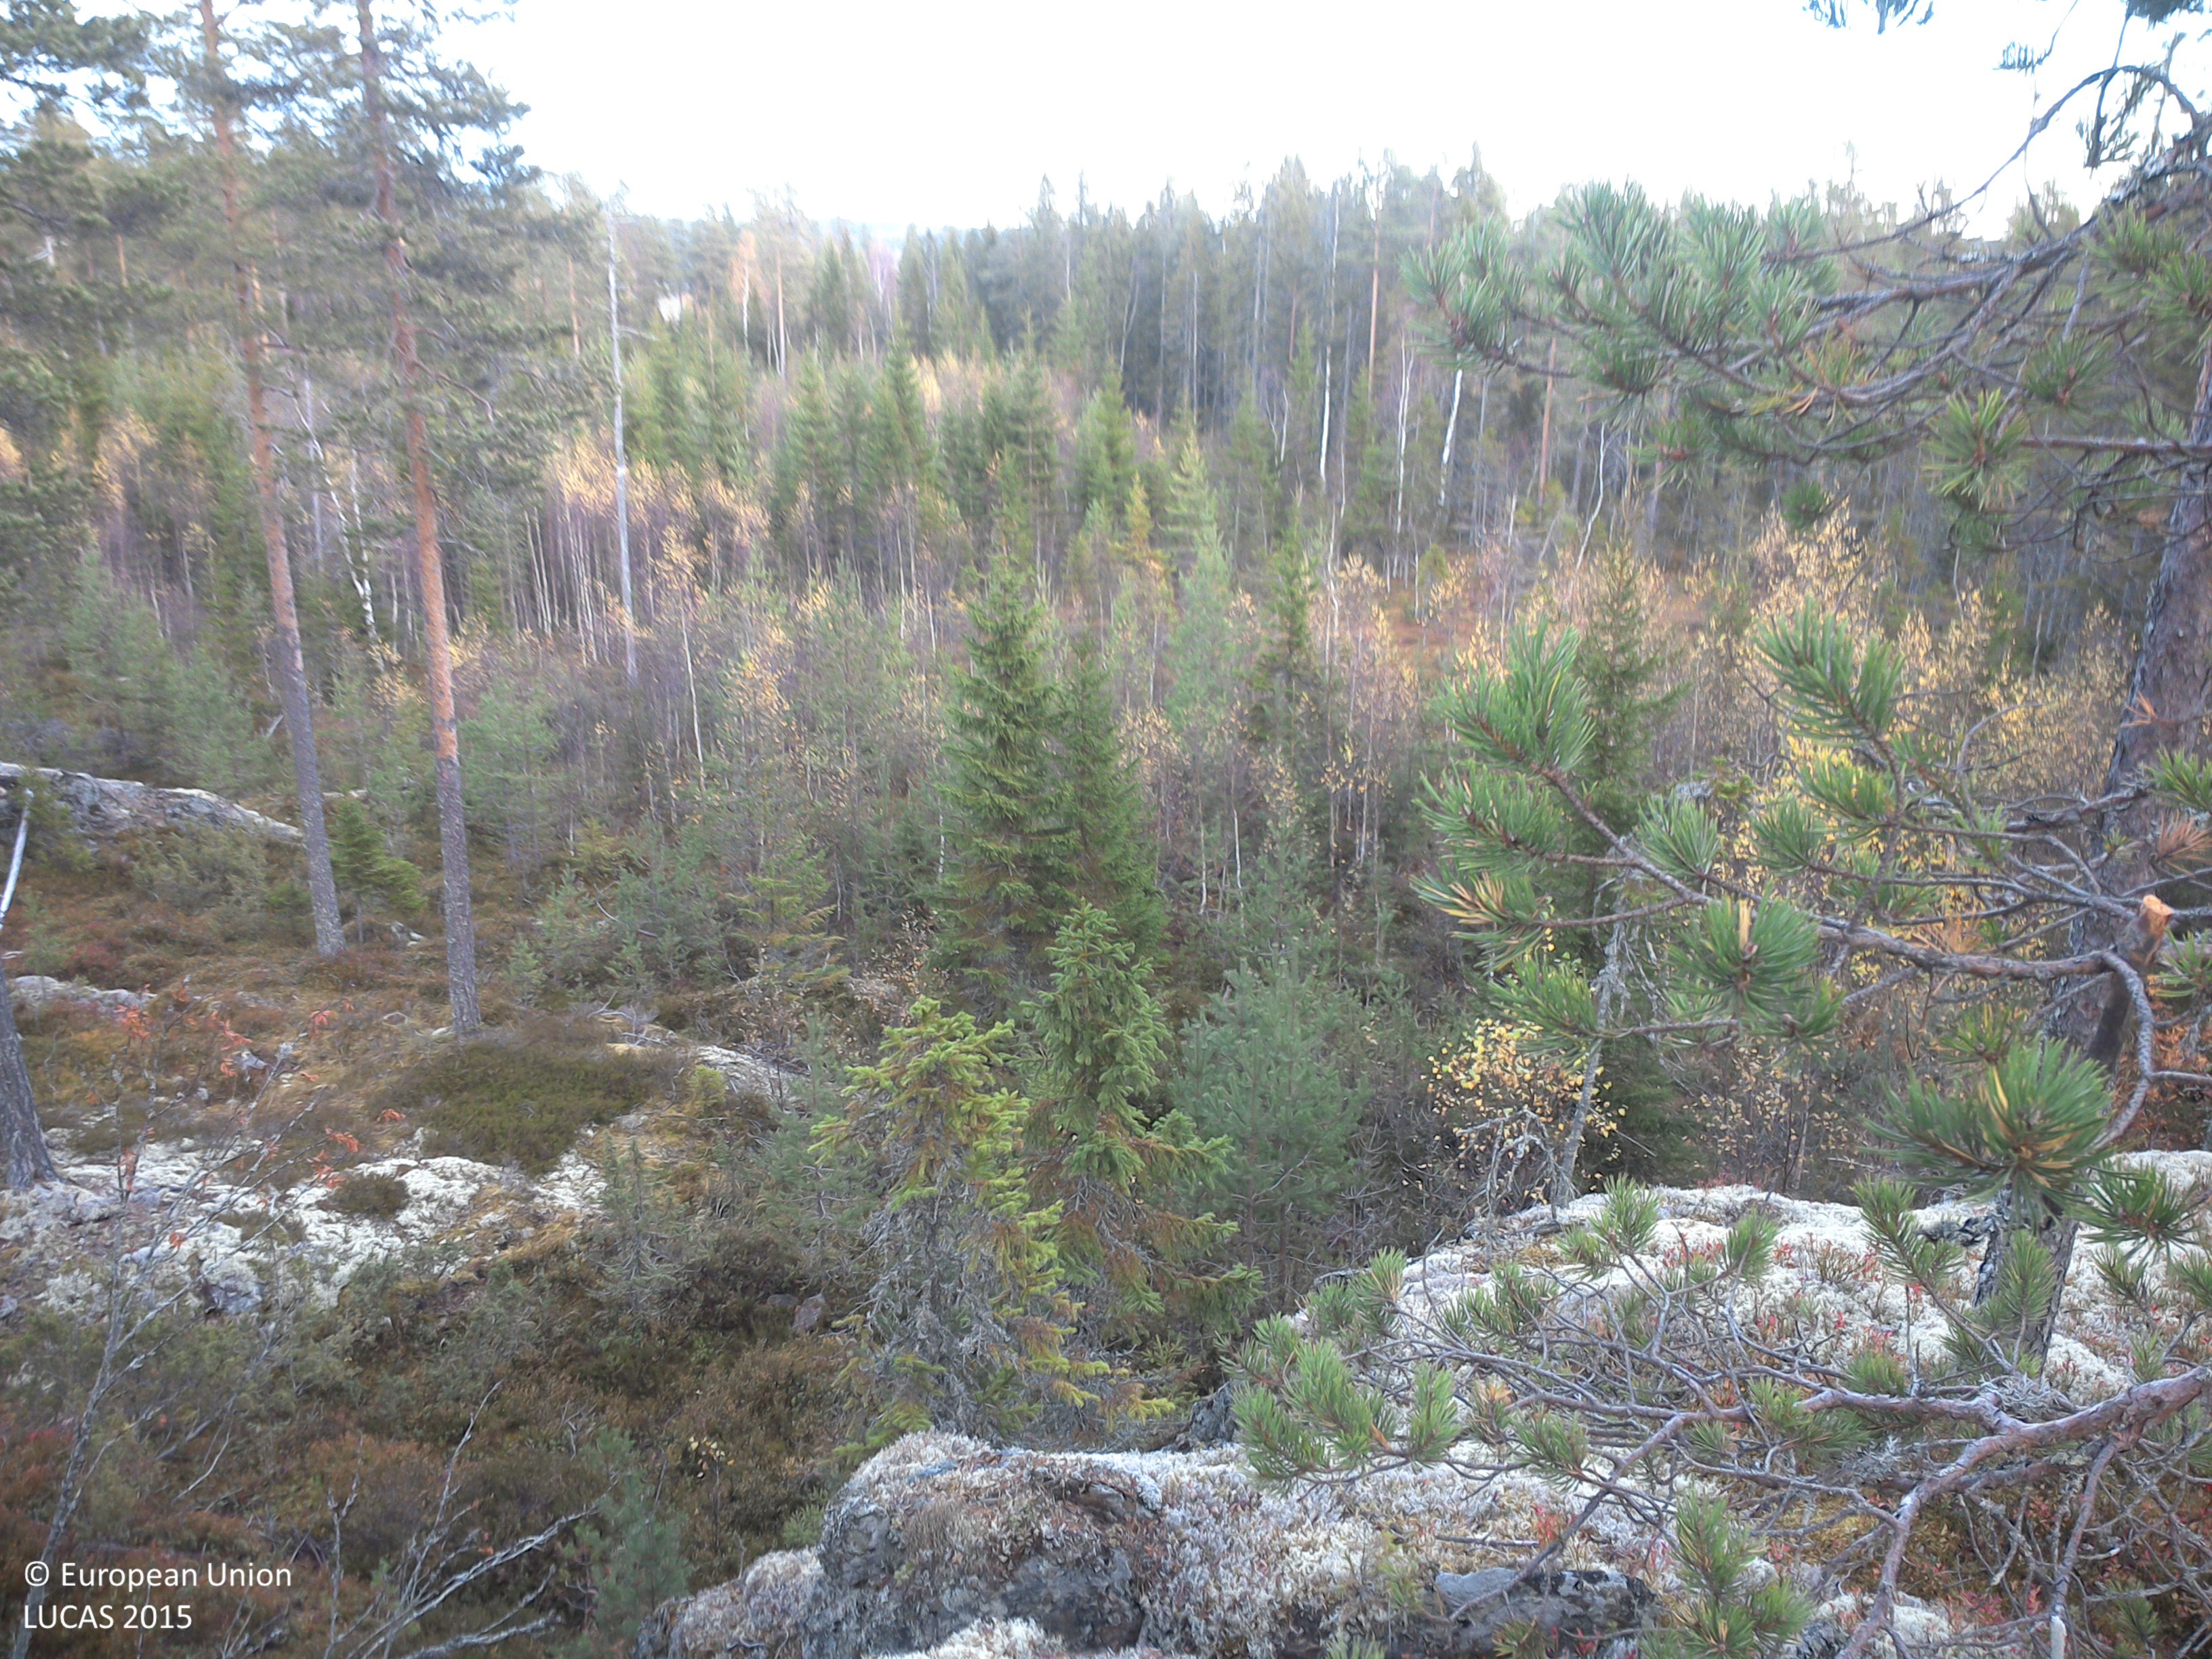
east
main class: Woodland
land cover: Pine dominated coniferous woodland
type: boreal forest
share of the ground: 25 - 50 %
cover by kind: coniferous forest trees 50 %, shrubs 20 %, lichens and mosses 20 %, consolidated bare surface 10 %
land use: Forestry
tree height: > 5 m
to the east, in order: Pine dominated coniferous woodland; Lichens and moss; Broadleaved woodland; Pine dominated mixed woodland; Other mixed woodland; Spruce dominated mixed woodland; Tracks; Spruce dominated mixed woodland
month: October
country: SE
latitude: 63.8524
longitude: 19.8841
